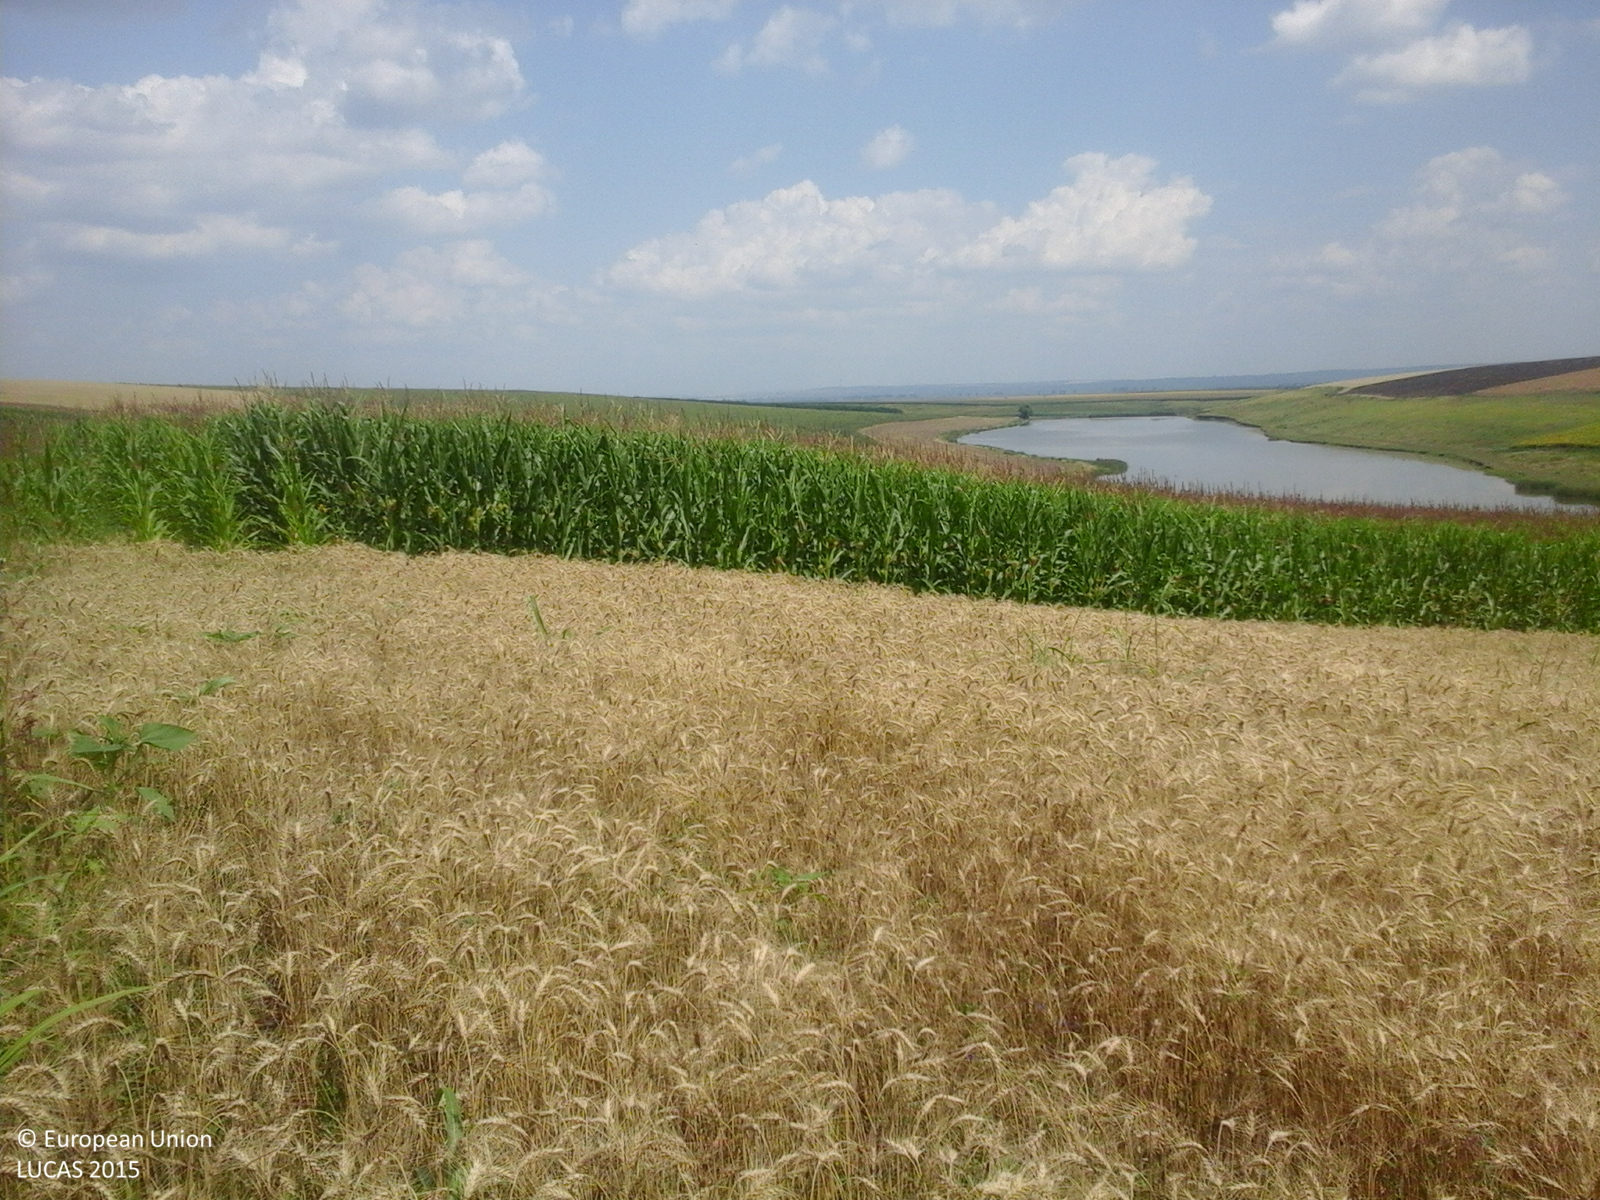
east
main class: Cropland
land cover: Sunflower
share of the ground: > 75 %
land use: Agriculture (excluding fallow land and kitchen gardens)
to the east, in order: Sunflower; Maize; Common wheat; Maize; Common wheat; Maize
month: July
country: RO
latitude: 43.8576
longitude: 25.7289
